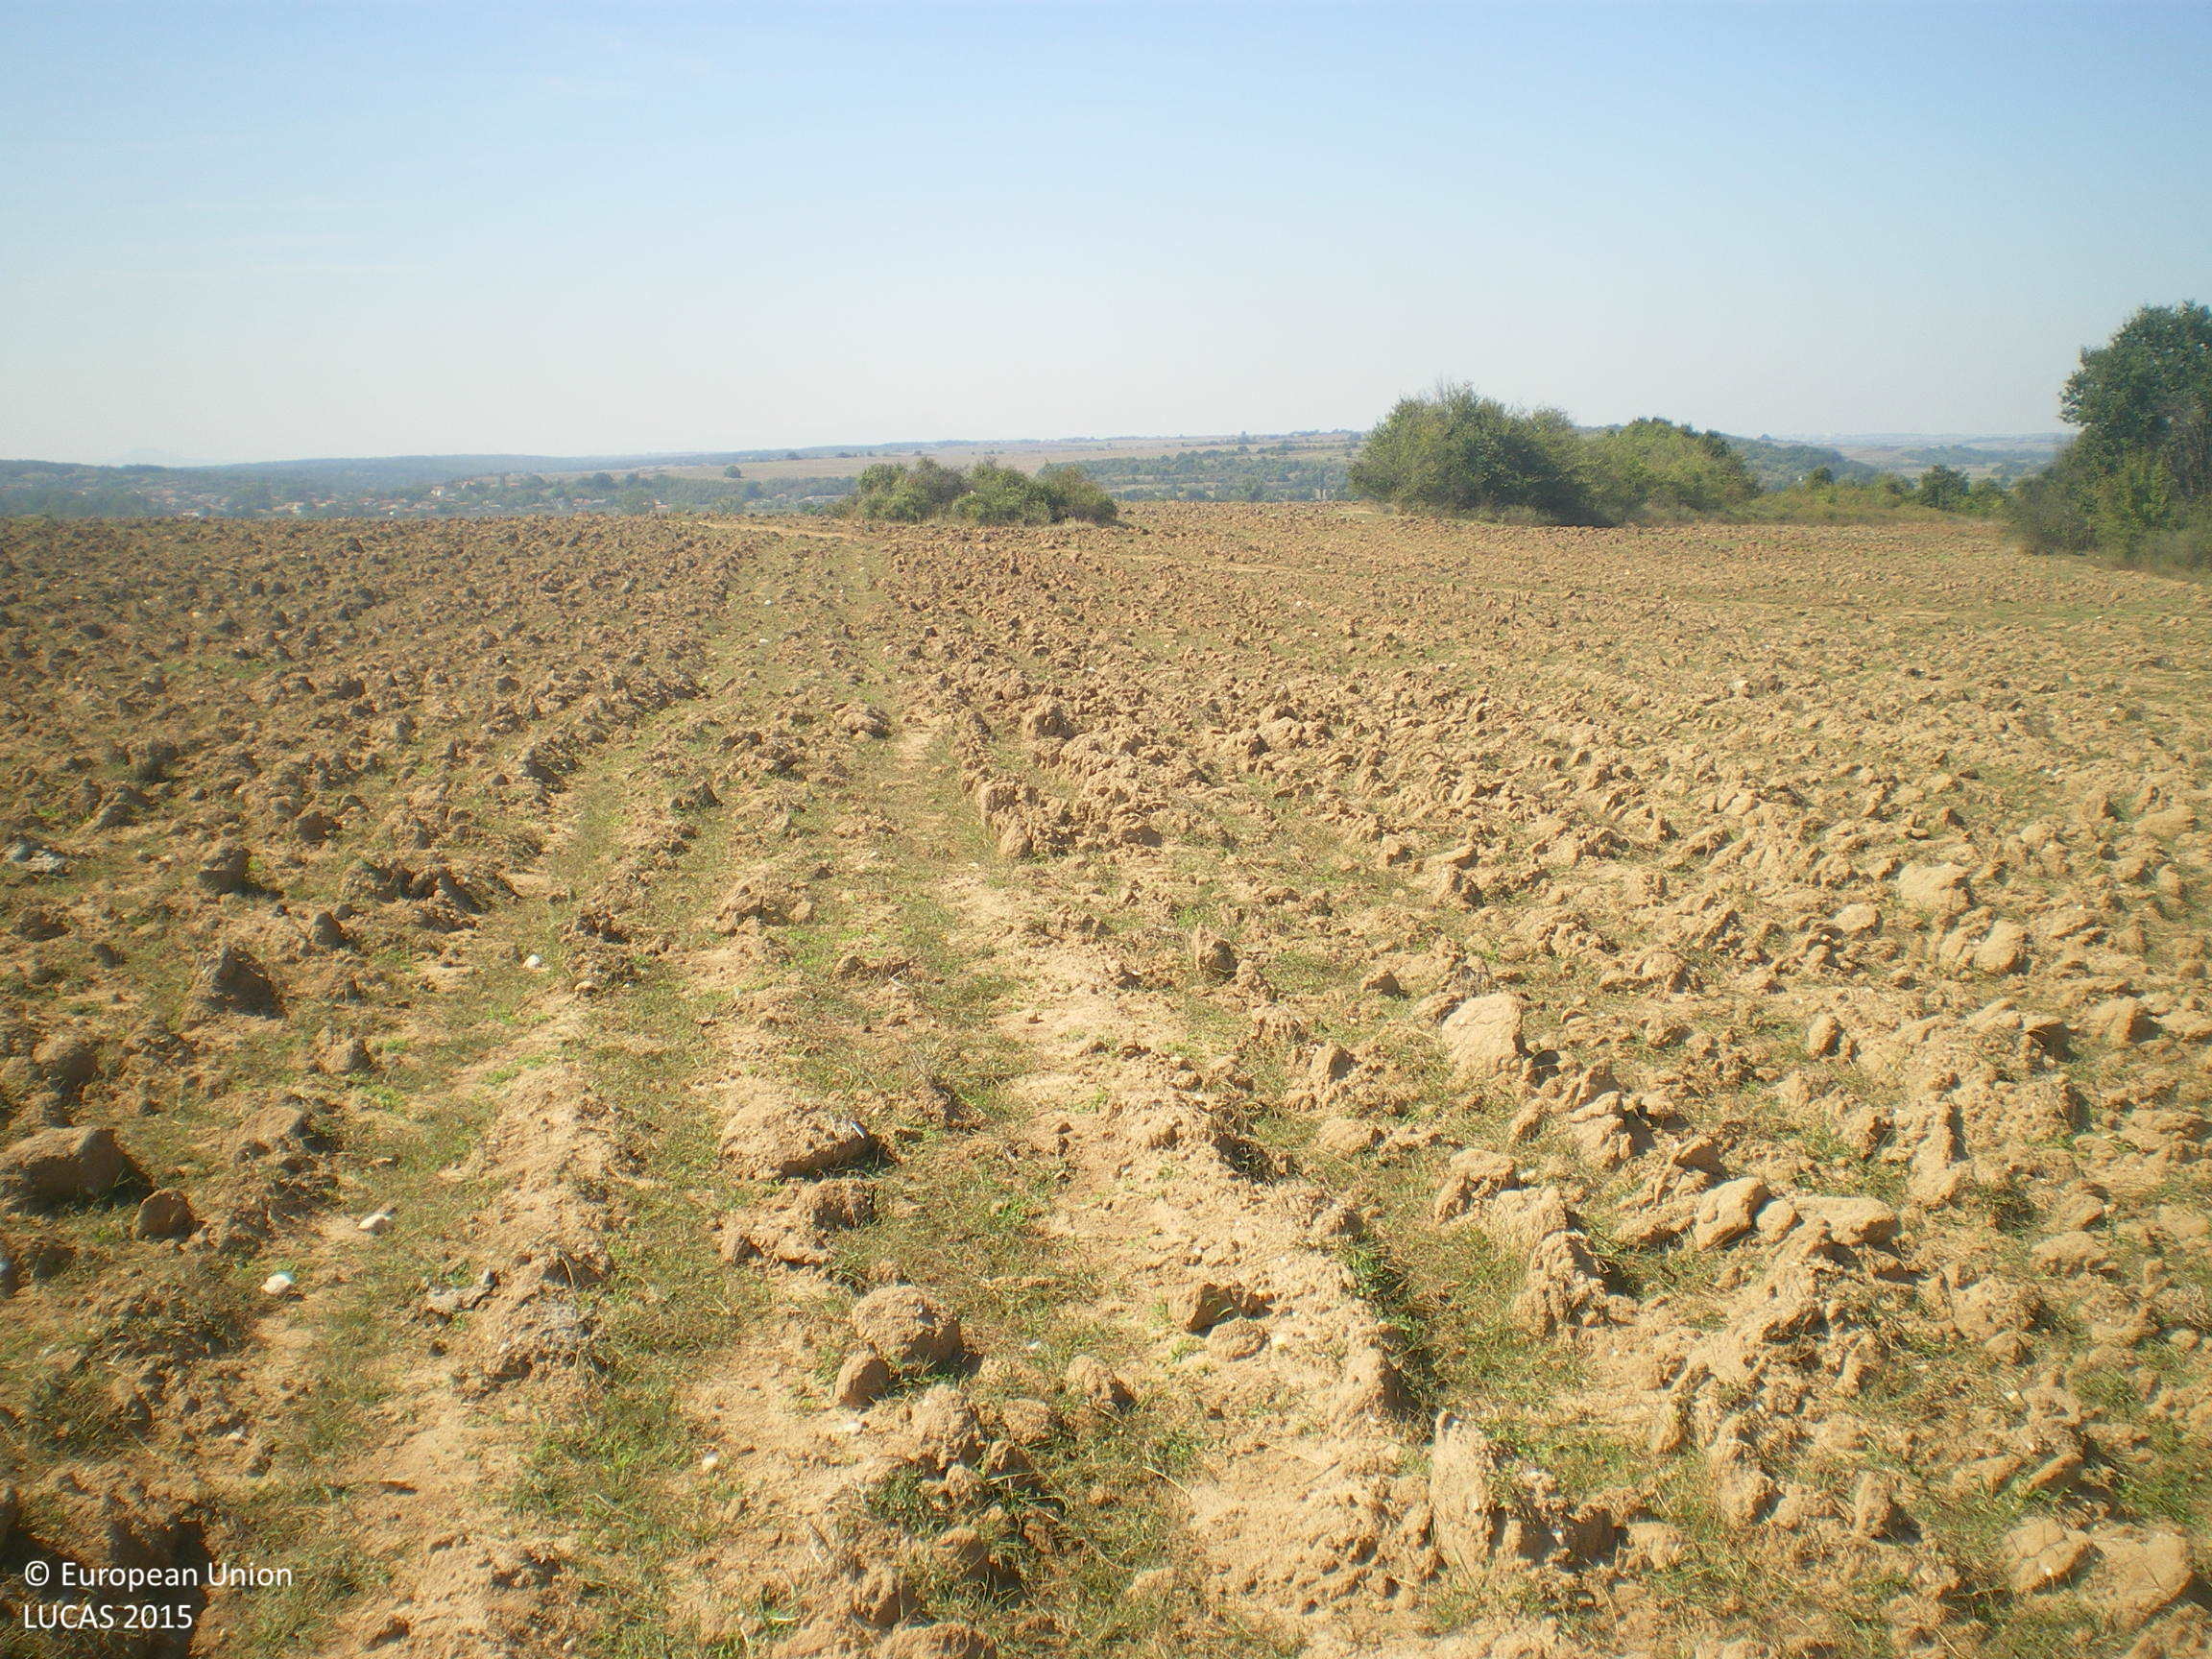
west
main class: Grassland
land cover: Spontaneously vegetated surfaces
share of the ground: 25 - 50 %
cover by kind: herbaceous plants 80 %, consolidated bare surface 20 %
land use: Agriculture (excluding fallow land and kitchen gardens)
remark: Harvested field
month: September
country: BG
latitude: 41.8944
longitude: 25.7239
